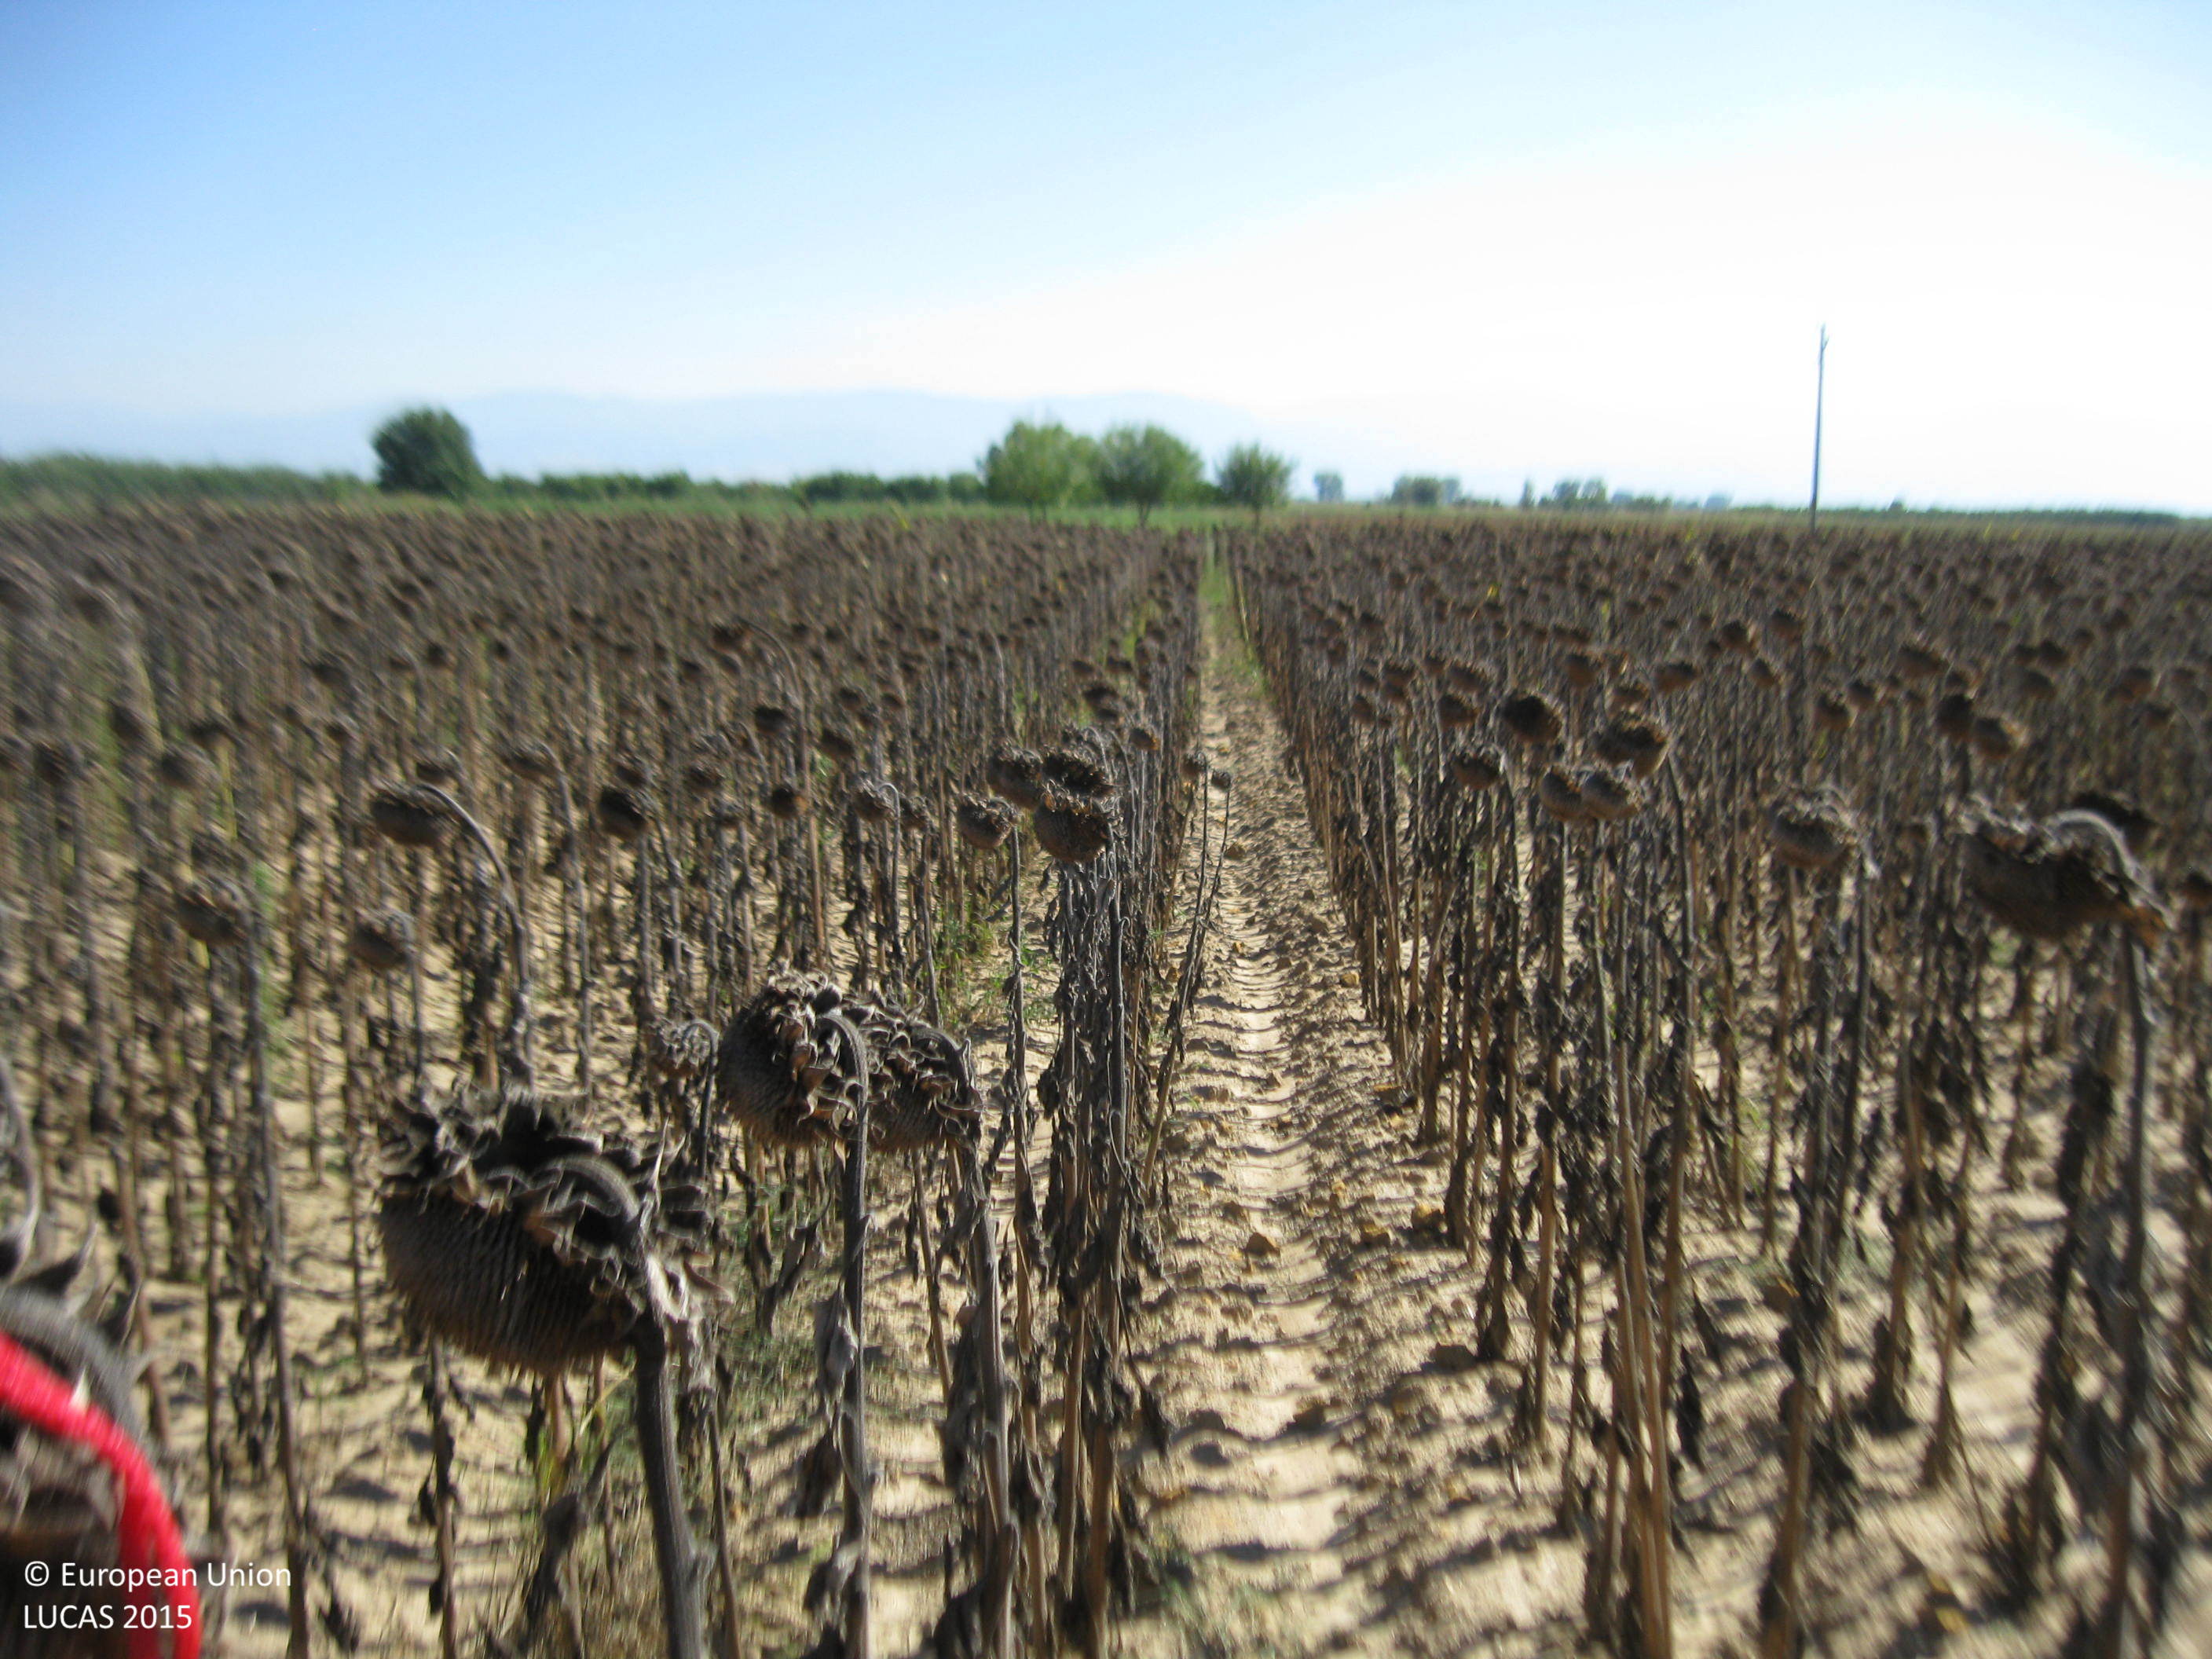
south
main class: Cropland
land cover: Sunflower
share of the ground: > 75 %
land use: Agriculture (excluding fallow land and kitchen gardens)
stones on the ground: < 10 %
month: September
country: BG
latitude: 42.2378
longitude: 24.6777
